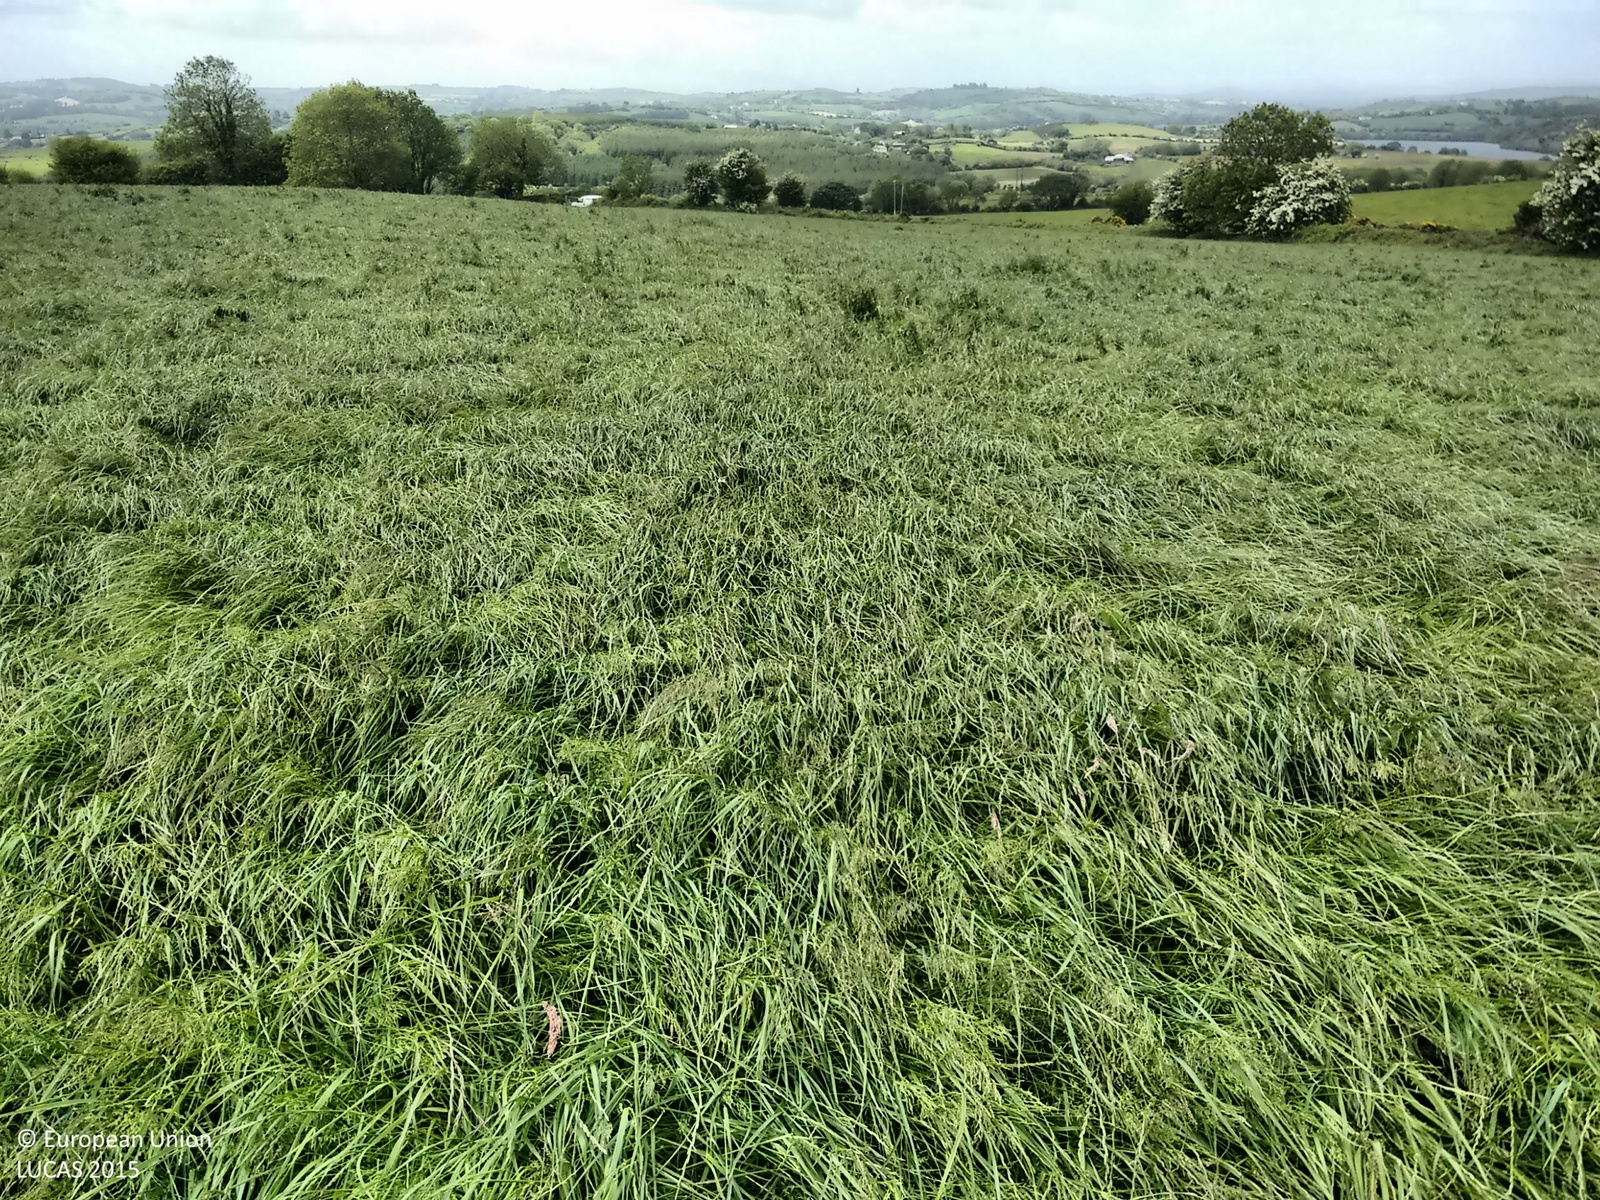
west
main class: Grassland
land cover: Grassland without tree/shrub cover
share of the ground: > 75 %
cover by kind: herbaceous plants 100 %
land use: Agriculture (excluding fallow land and kitchen gardens)
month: June
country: IE
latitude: 51.8782
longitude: -8.8745
